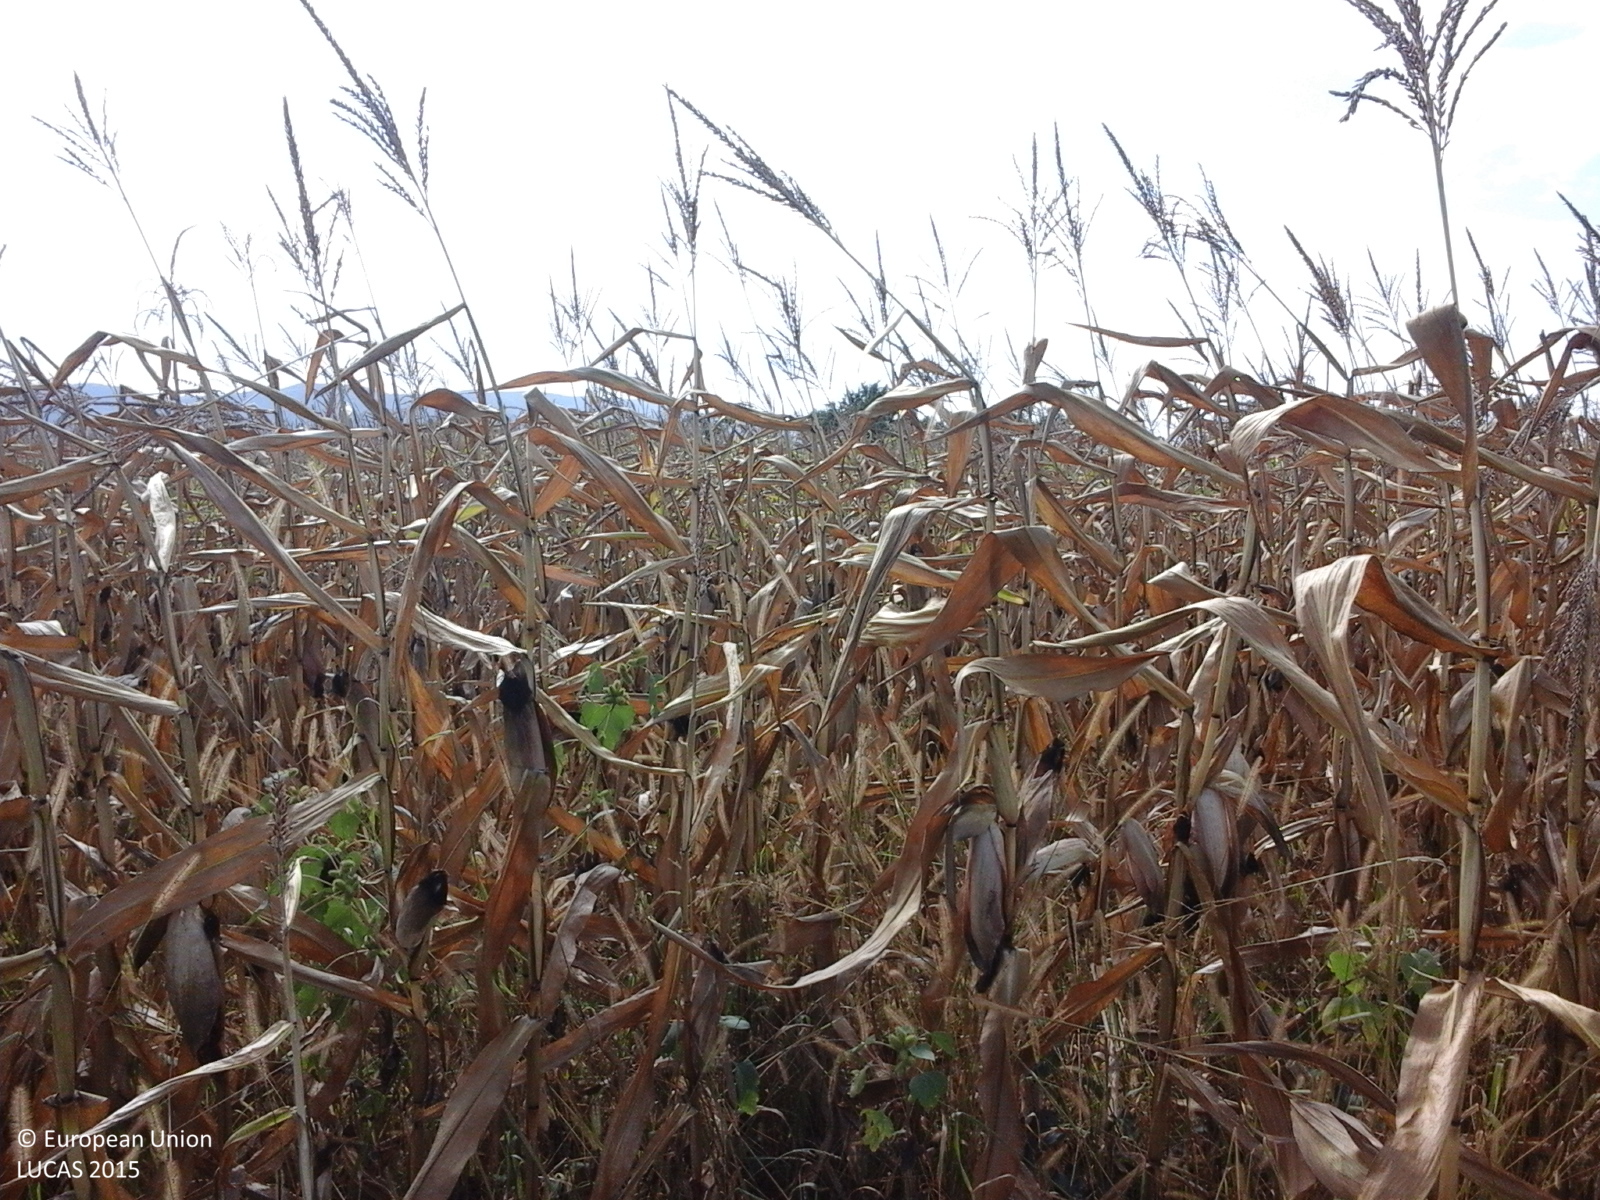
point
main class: Cropland
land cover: Maize
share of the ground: > 75 %
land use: Agriculture (excluding fallow land and kitchen gardens)
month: September
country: RO
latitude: 47.5036
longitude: 23.3067
